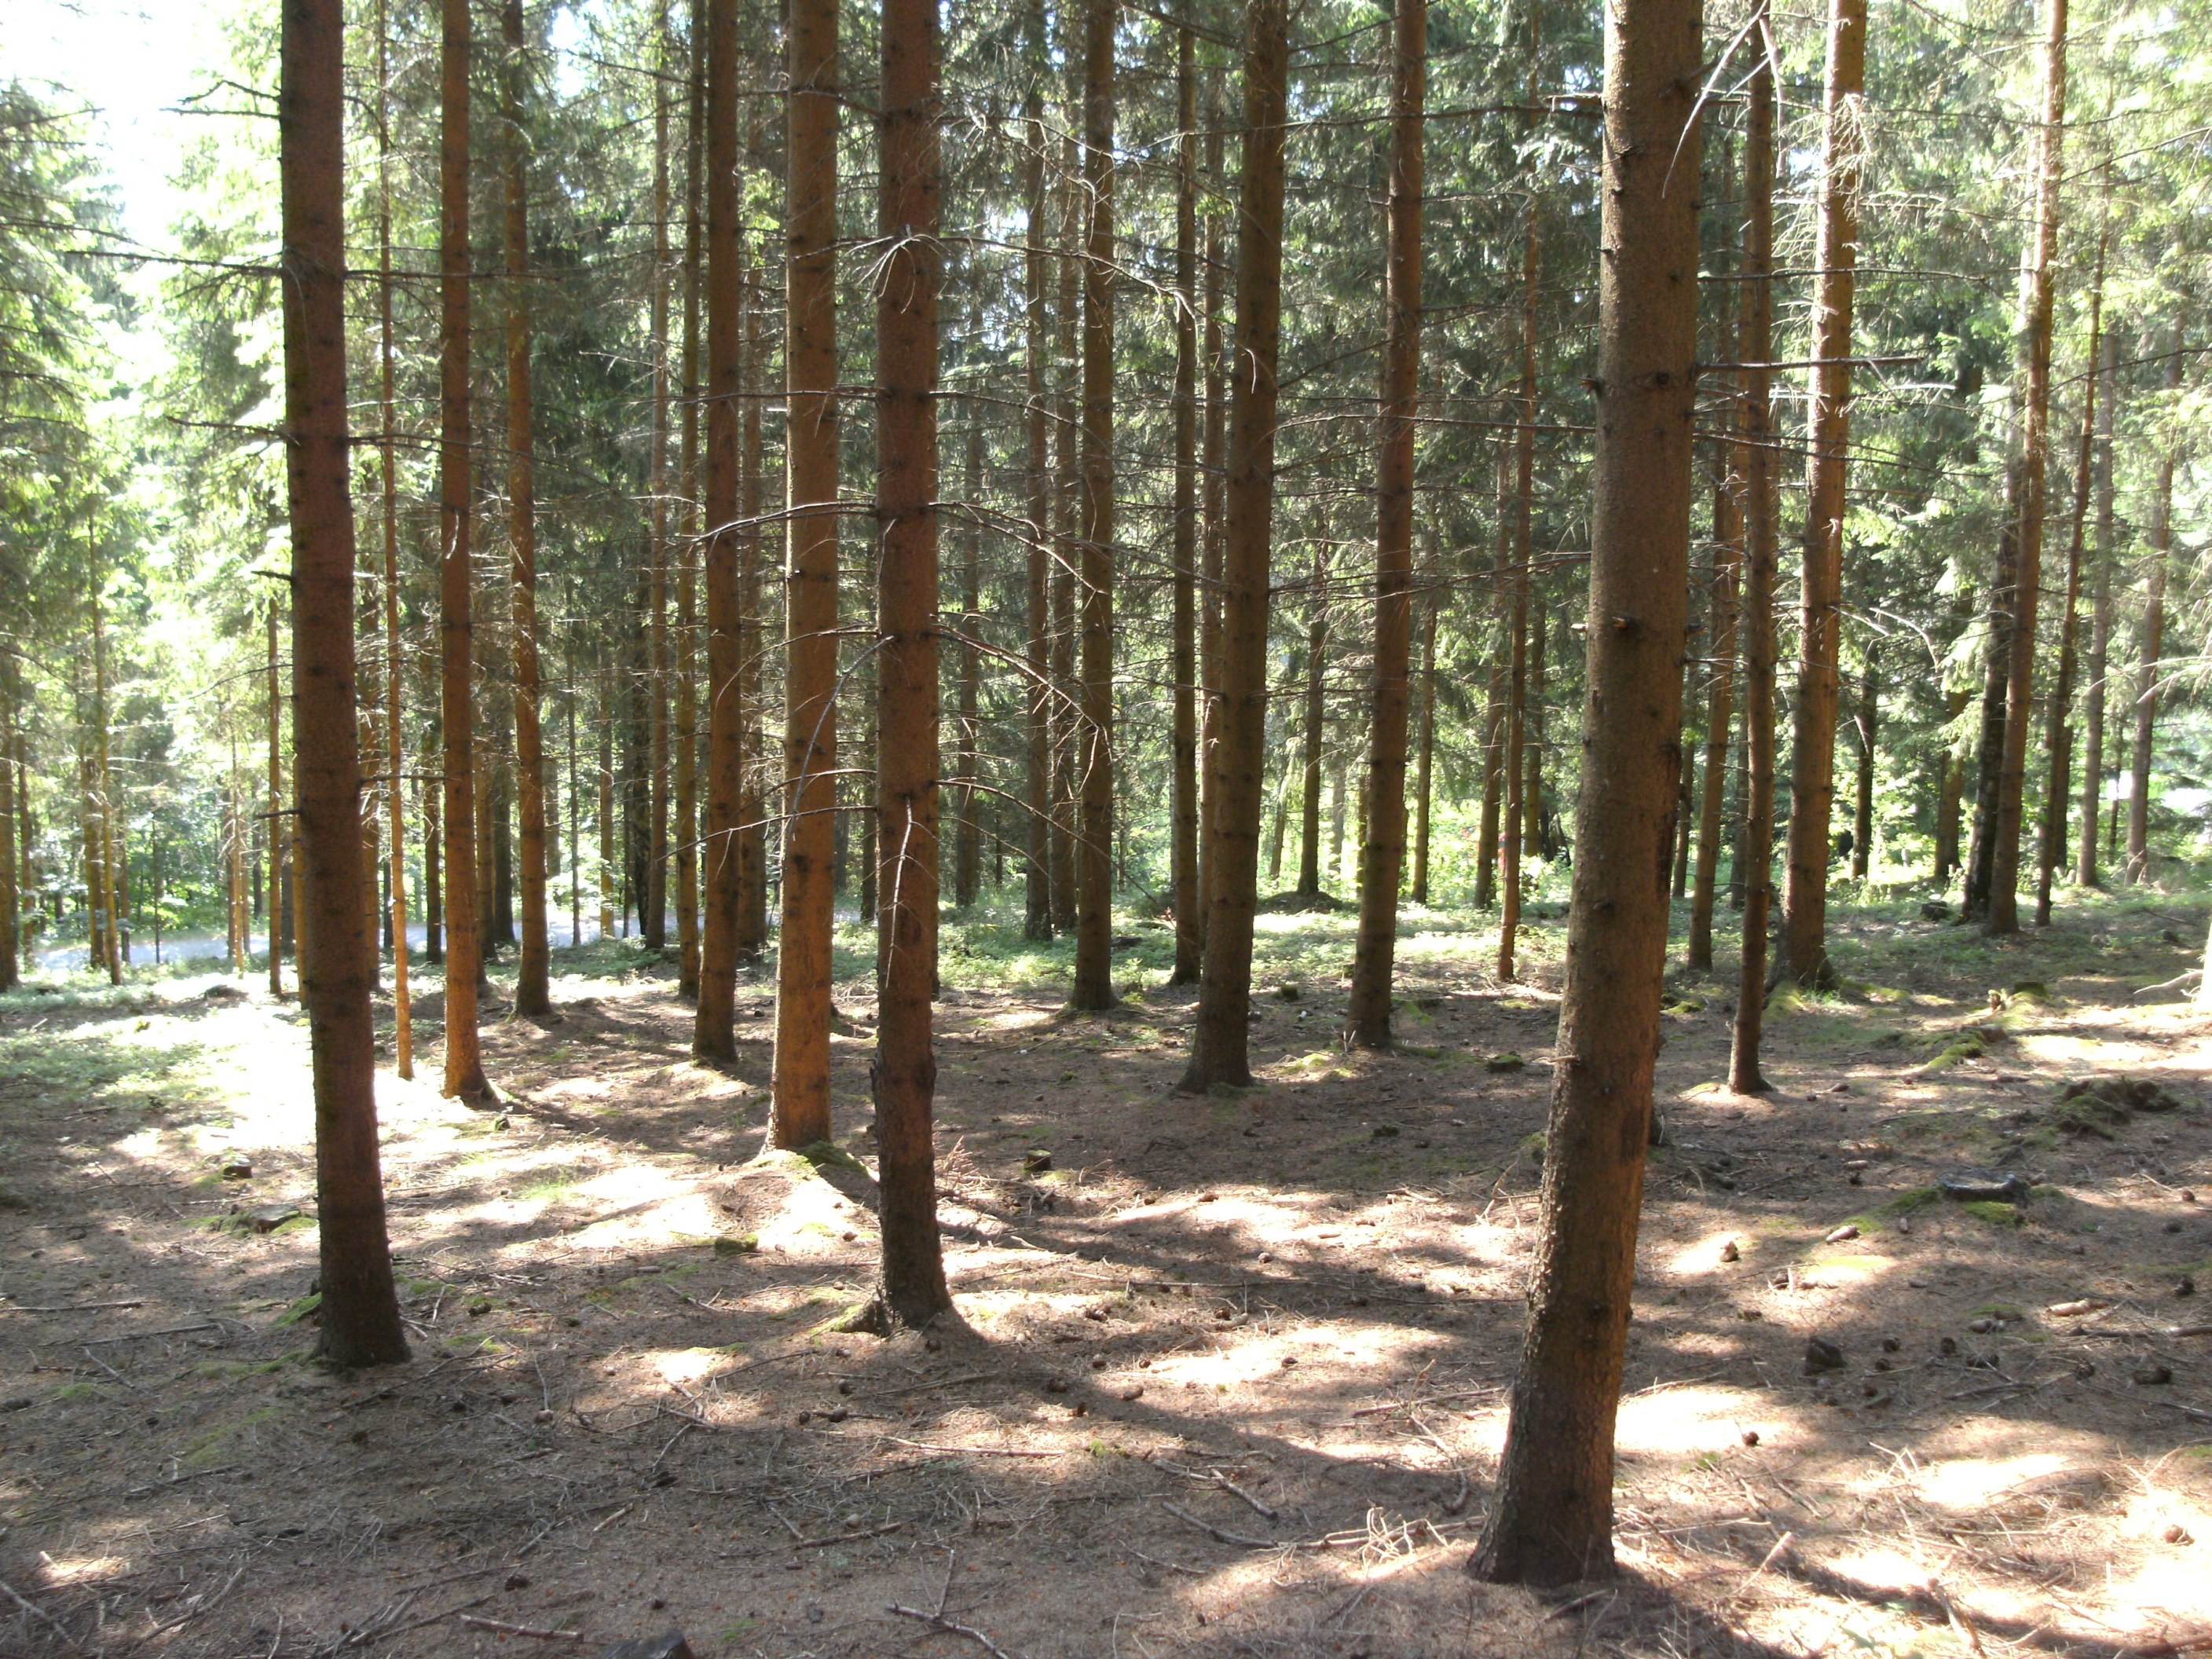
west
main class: Woodland
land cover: Spruce dominated coniferous woodland
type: hemiboreal forest and nemoral coniferous forest and mixed broadleaved-coniferous forest
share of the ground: > 75 %
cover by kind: coniferous forest trees 90 %, unconsolidated bare surface 10 %
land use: Forestry
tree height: > 5 m
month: June
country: AT
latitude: 48.4327
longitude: 14.1765
